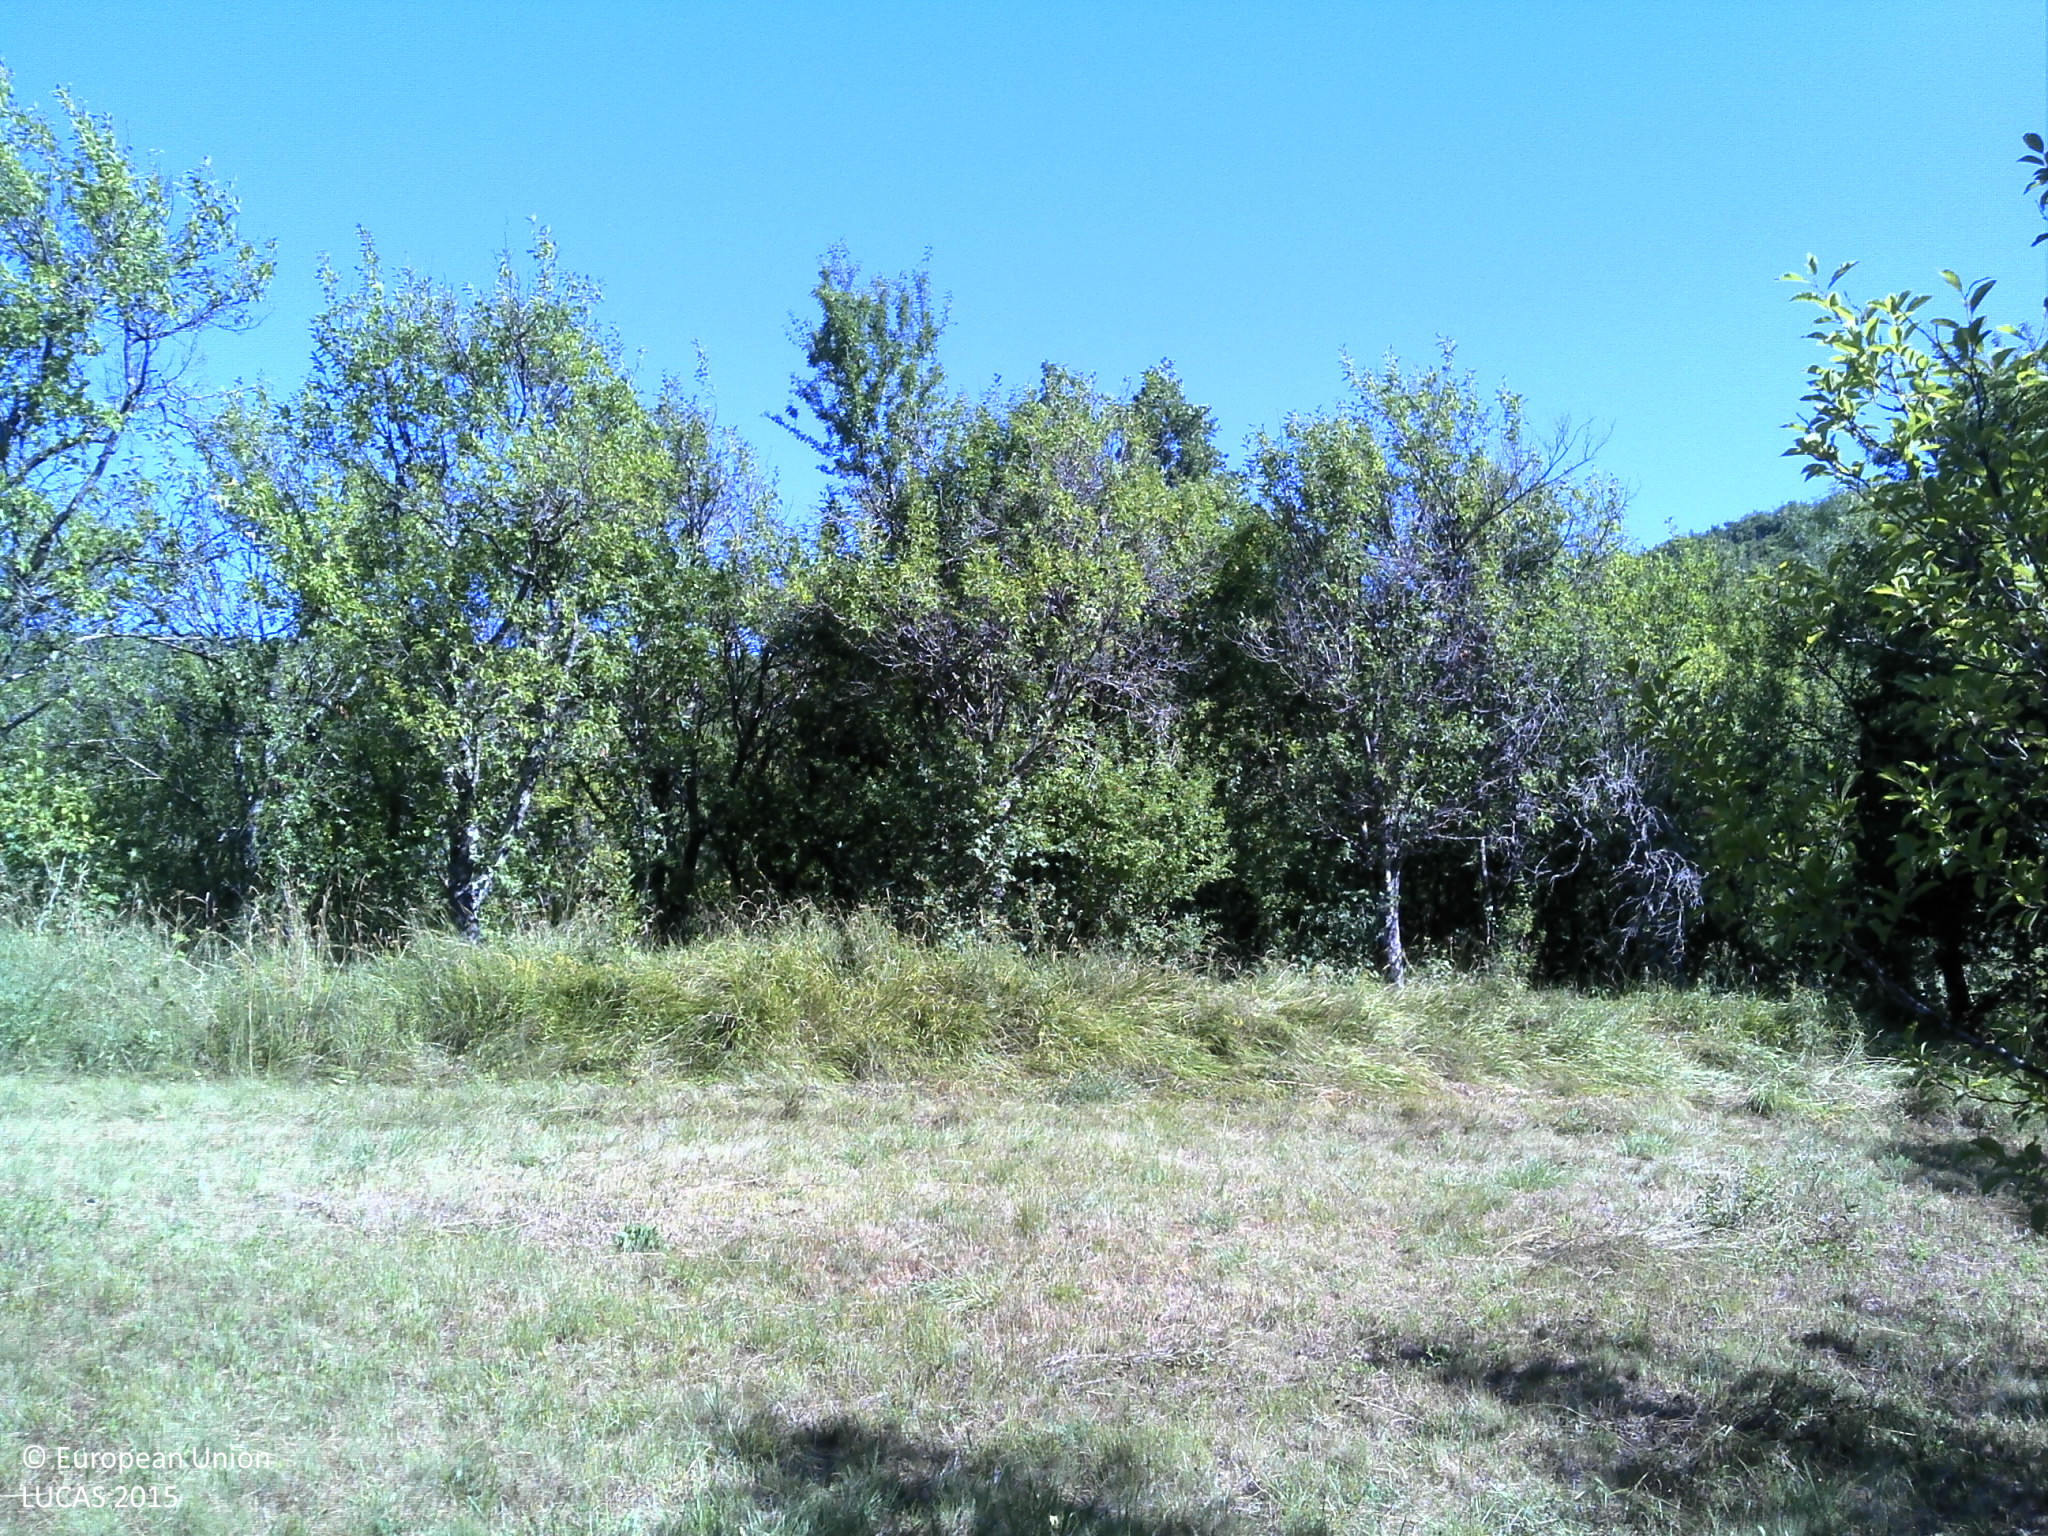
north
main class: Woodland
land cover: Broadleaved woodland
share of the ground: 25 - 50 %
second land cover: Grassland without tree/shrub cover
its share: > 75 %
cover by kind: herbaceous plants 65 %, broadleaved forest trees 25 %, shrubs 10 %
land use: Forestry
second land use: Agriculture (excluding fallow land and kitchen gardens)
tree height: < 5 m
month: July
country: HR
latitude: 44.1331
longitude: 16.1297
